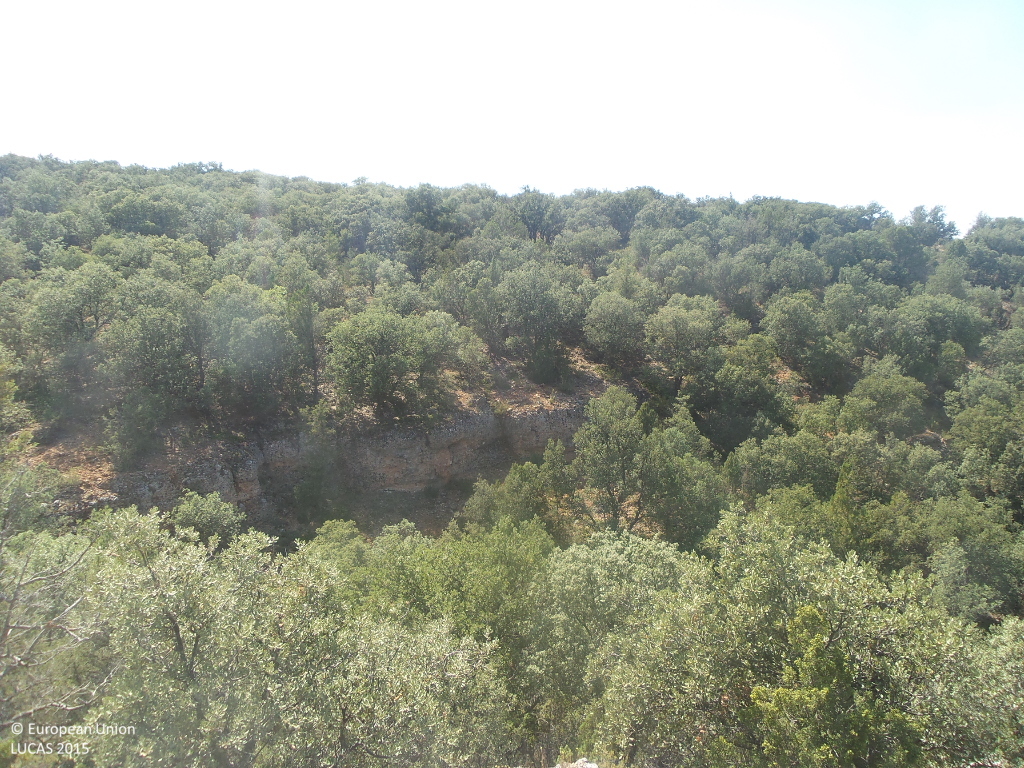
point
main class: Woodland
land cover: Broadleaved woodland
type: broadleaved evergreen forest
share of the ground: > 75 %
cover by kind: broadleaved forest trees 80 %, unconsolidated bare surface 10 %, shrubs 5 %, herbaceous plants 5 %
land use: Semi-natural and natural areas not in use
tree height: > 5 m
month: July
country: ES
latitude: 41.1536
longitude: -2.1468
